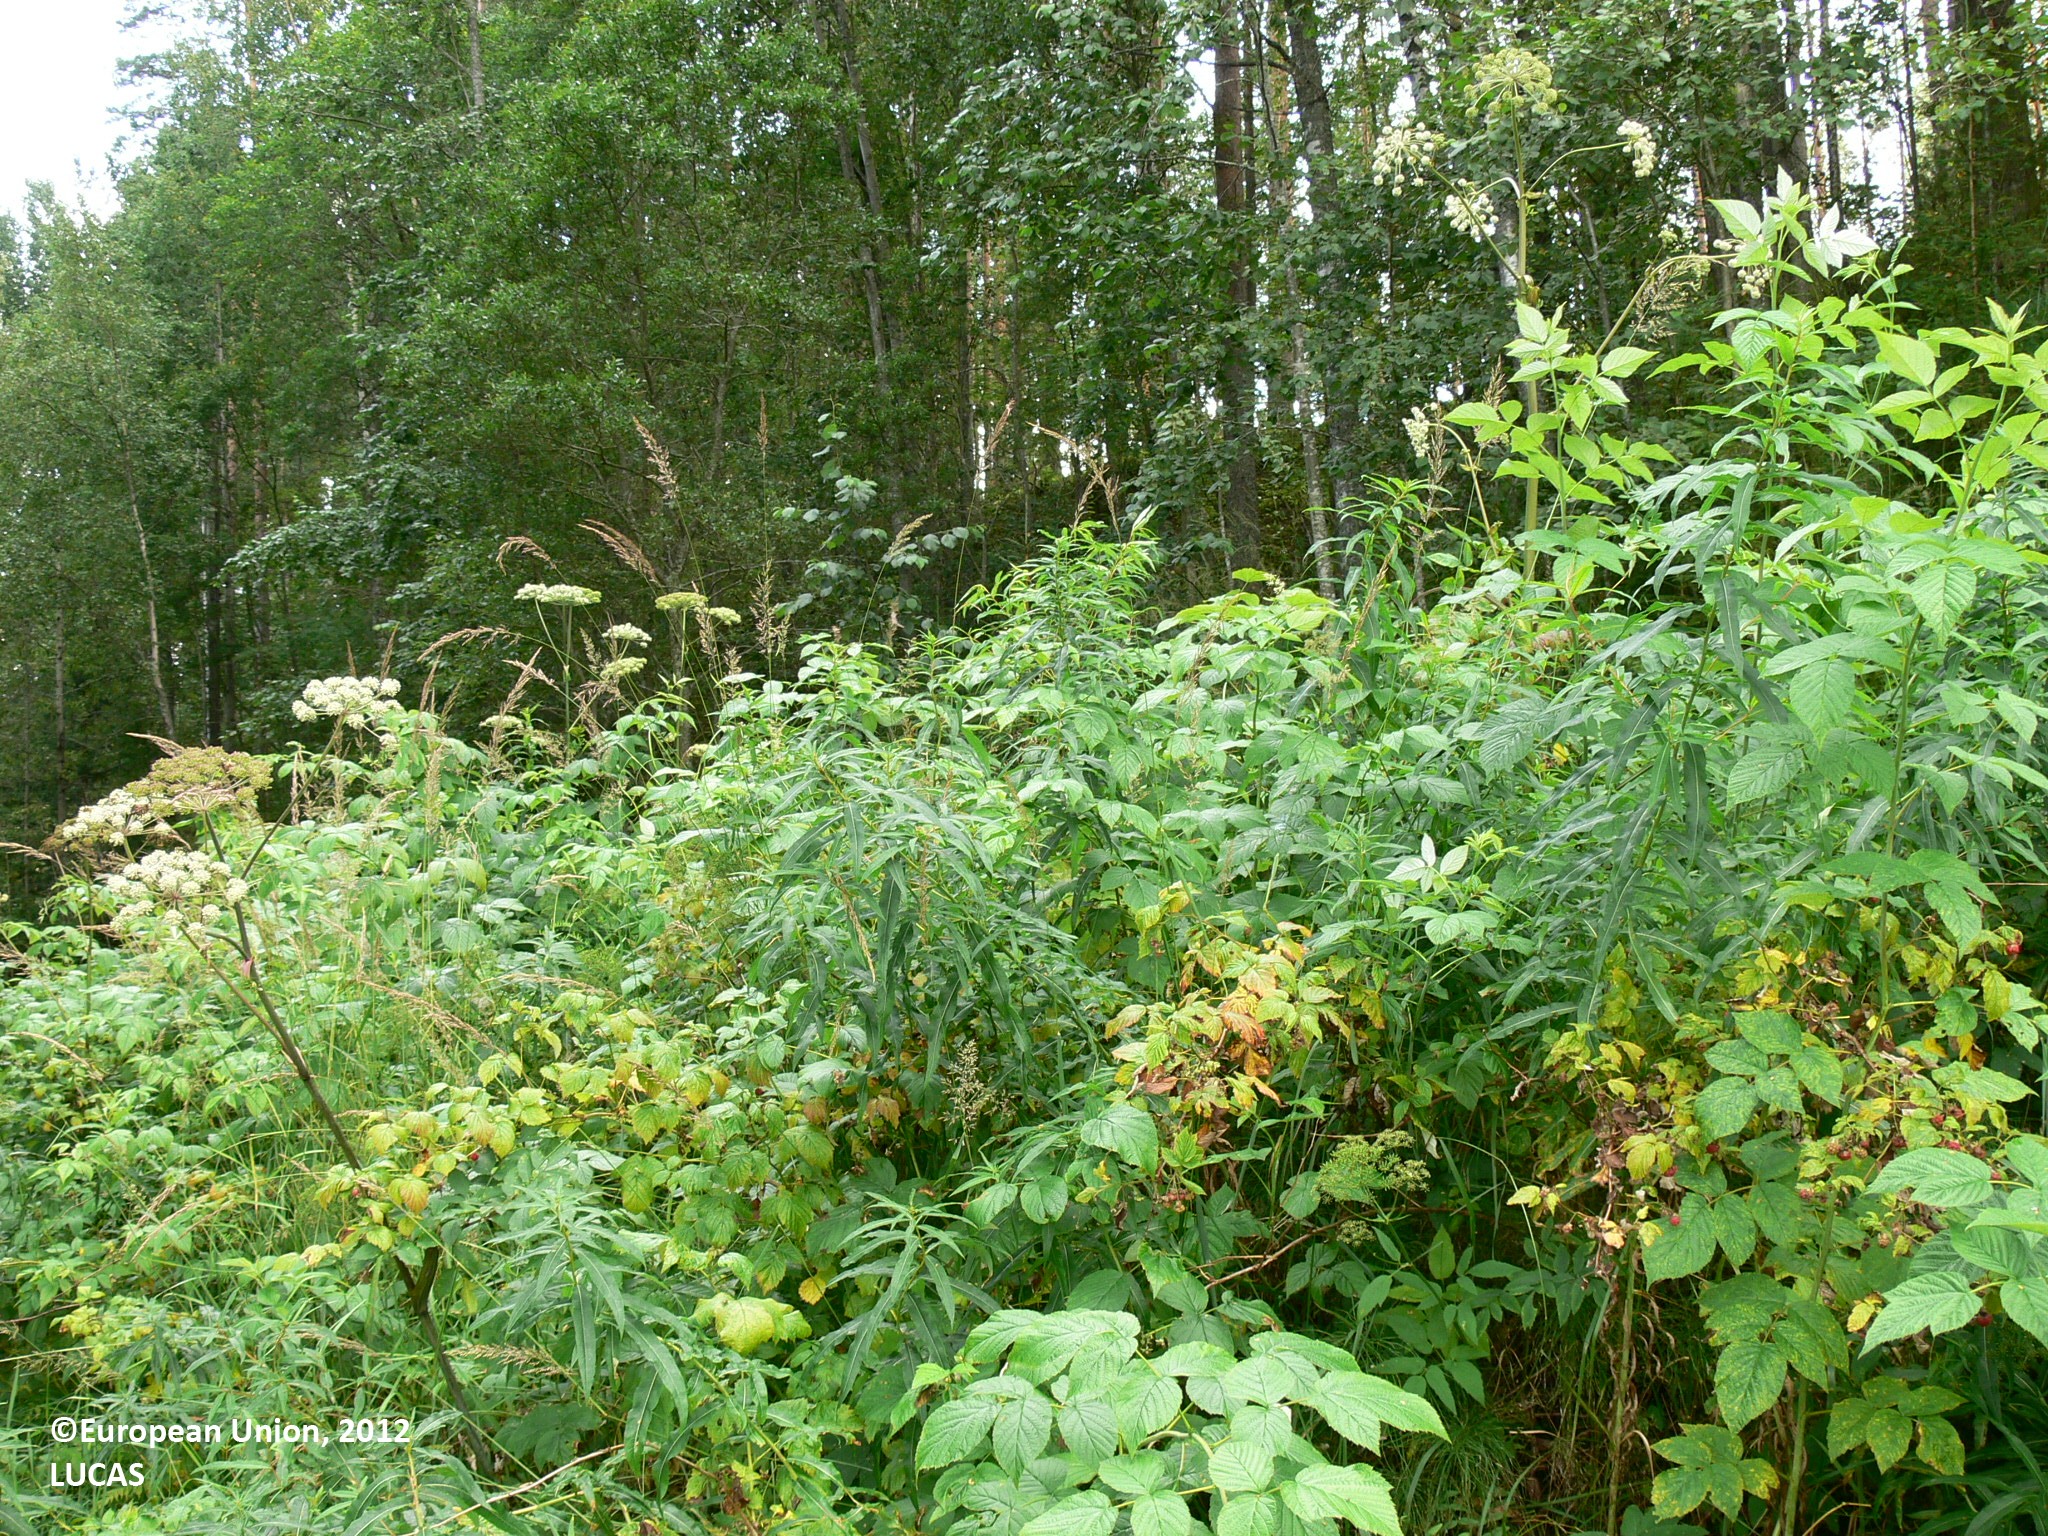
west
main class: Cropland
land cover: Oats
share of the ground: > 75 %
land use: Agriculture (excluding fallow land and kitchen gardens)
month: August
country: FI
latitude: 61.8526
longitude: 29.2582
